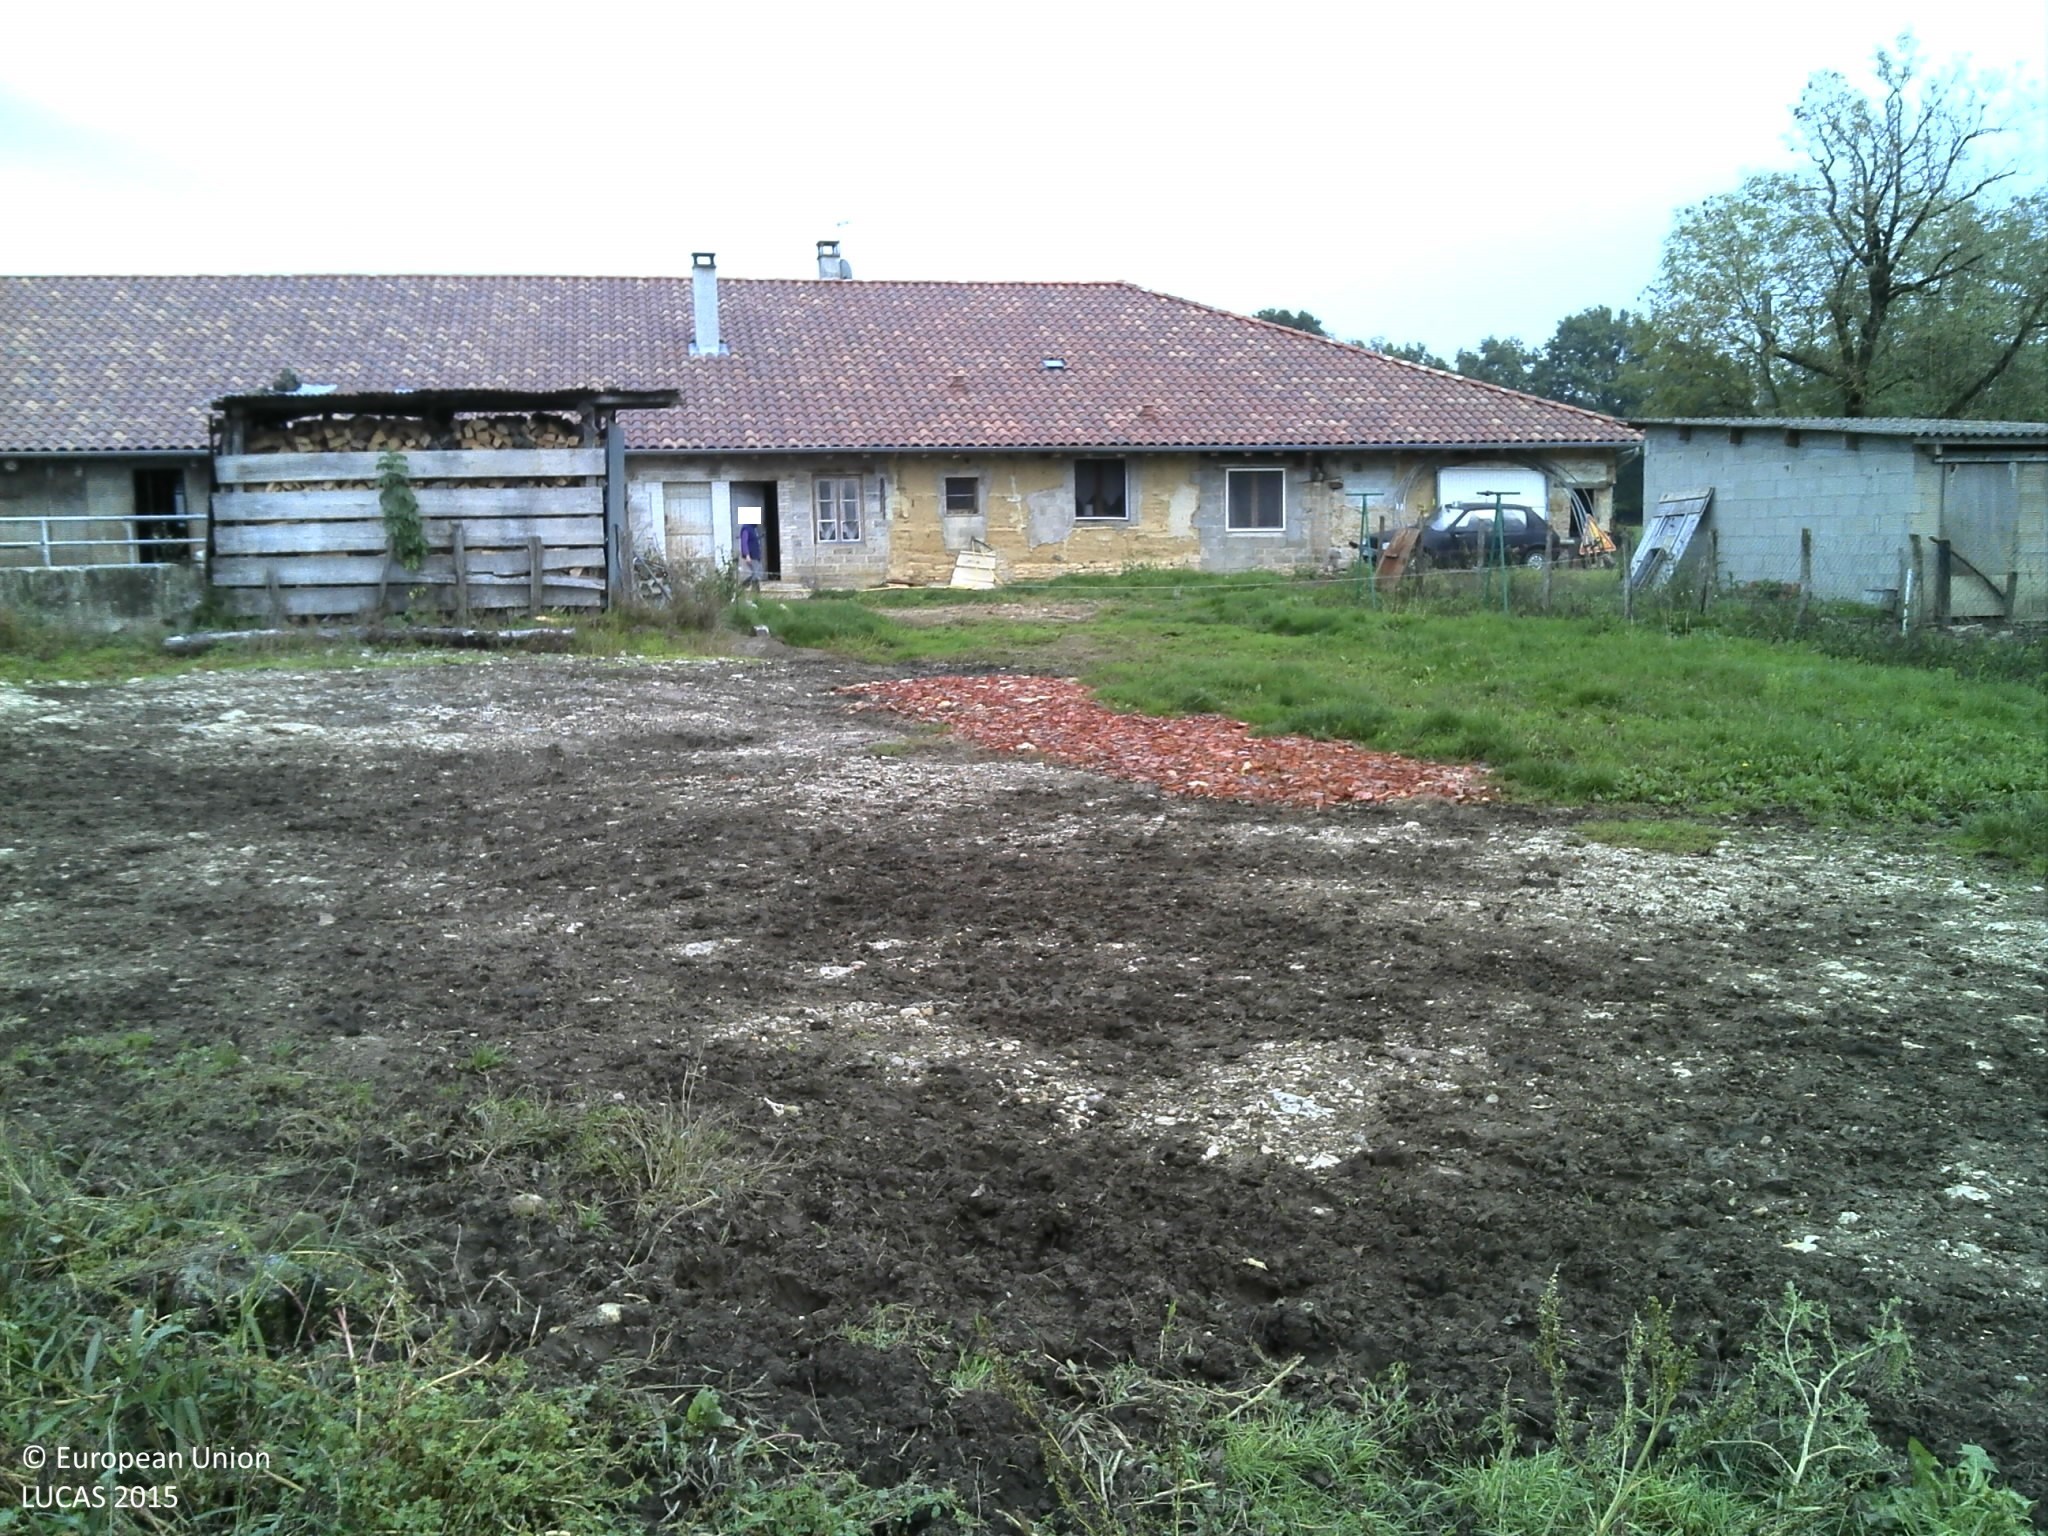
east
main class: Grassland
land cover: Spontaneously vegetated surfaces
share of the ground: > 75 %
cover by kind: herbaceous plants 100 %
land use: Semi-natural and natural areas not in use
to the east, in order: Spontaneously vegetated surfaces; Other bare soil; Artificial constructions in urban areas; Grassland without tree/shrub cover; Fences; Ditches and canals; Grassland without tree/shrub cover
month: October
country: FR
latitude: 46.3028
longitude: 5.3158
